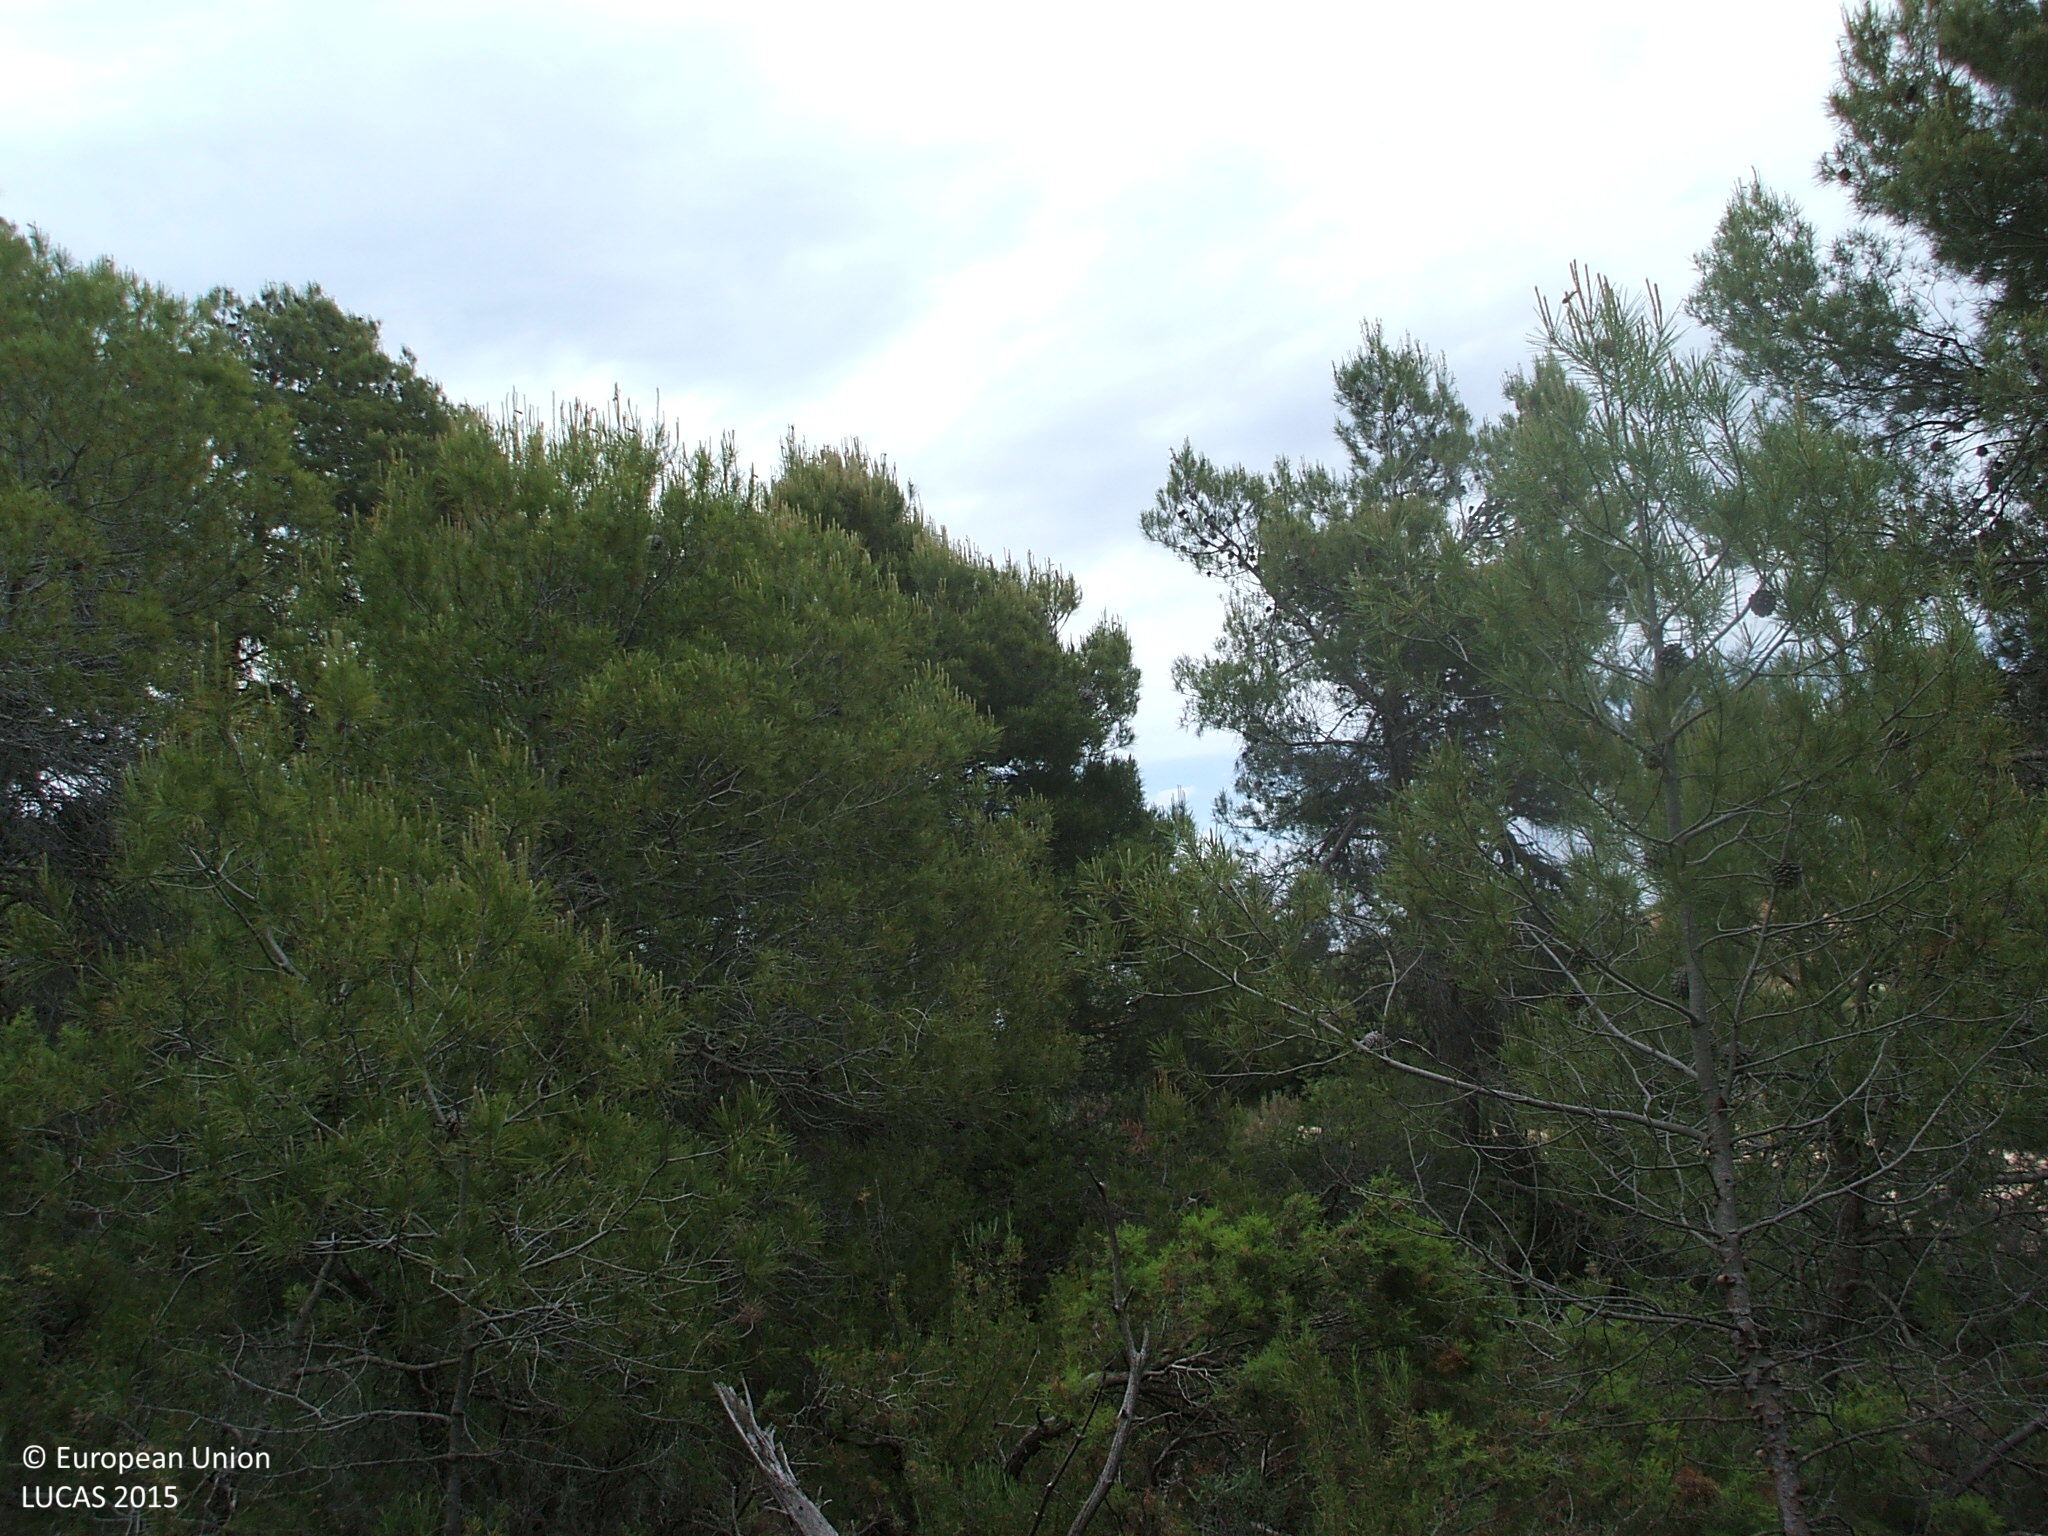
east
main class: Woodland
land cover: Pine dominated coniferous woodland
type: coniferous forest of the mediterranean region
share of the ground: > 75 %
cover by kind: coniferous forest trees 100 %
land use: Semi-natural and natural areas not in use
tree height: > 5 m
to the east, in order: Pine dominated coniferous woodland; Other bare soil; Shruby margins; Paved roads, cycling and walking lanes; Grass margins; Tracks; Grass margins; Shrubland with sparse tree cover; Nuts trees; Pine dominated coniferous woodland
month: June
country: ES
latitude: 40.8268
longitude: -0.0284
